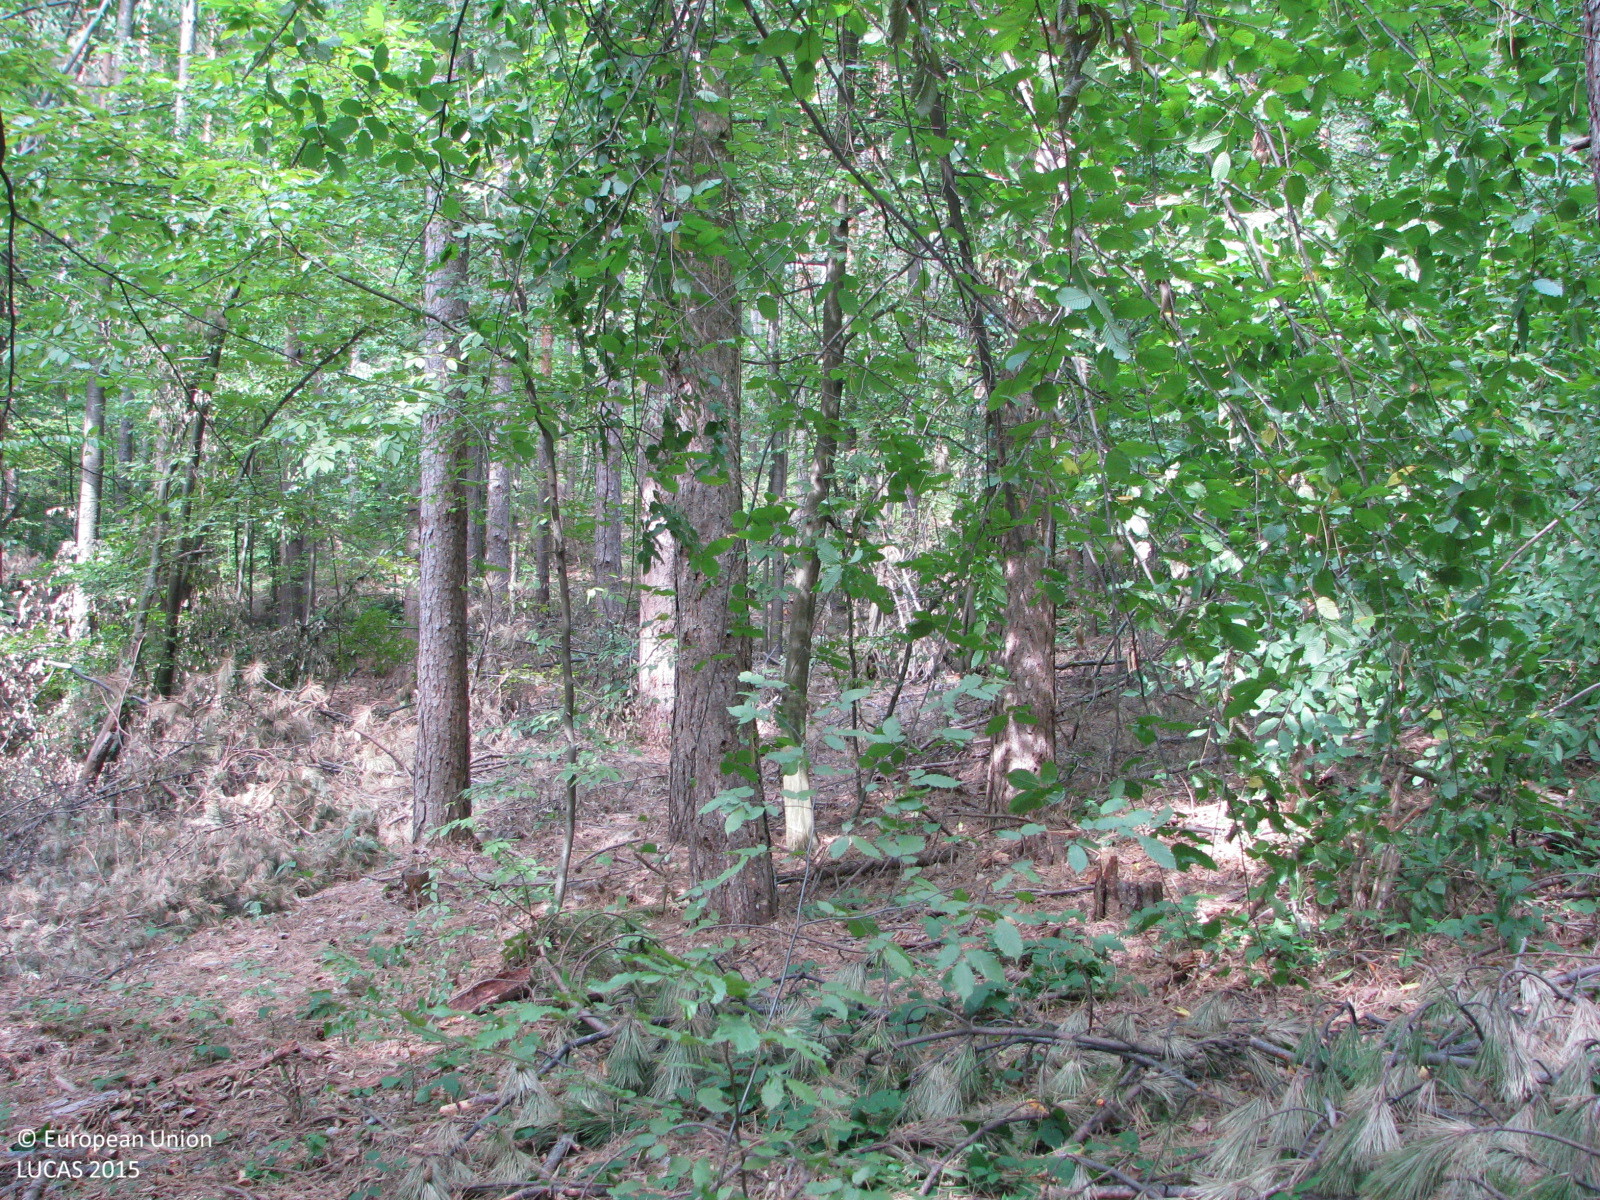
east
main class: Woodland
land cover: Pine dominated mixed woodland
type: coniferous forest of the mediterranean region
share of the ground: > 75 %
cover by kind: coniferous forest trees 45 %, broadleaved forest trees 30 %, consolidated bare surface 15 %, shrubs 5 %, herbaceous plants 5 %
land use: Forestry
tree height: > 5 m
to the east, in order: Pine dominated mixed woodland; Tracks; Pine dominated mixed woodland; Broadleaved woodland; Tracks; Broadleaved woodland
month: August
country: BG
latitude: 42.8538
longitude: 26.1569
